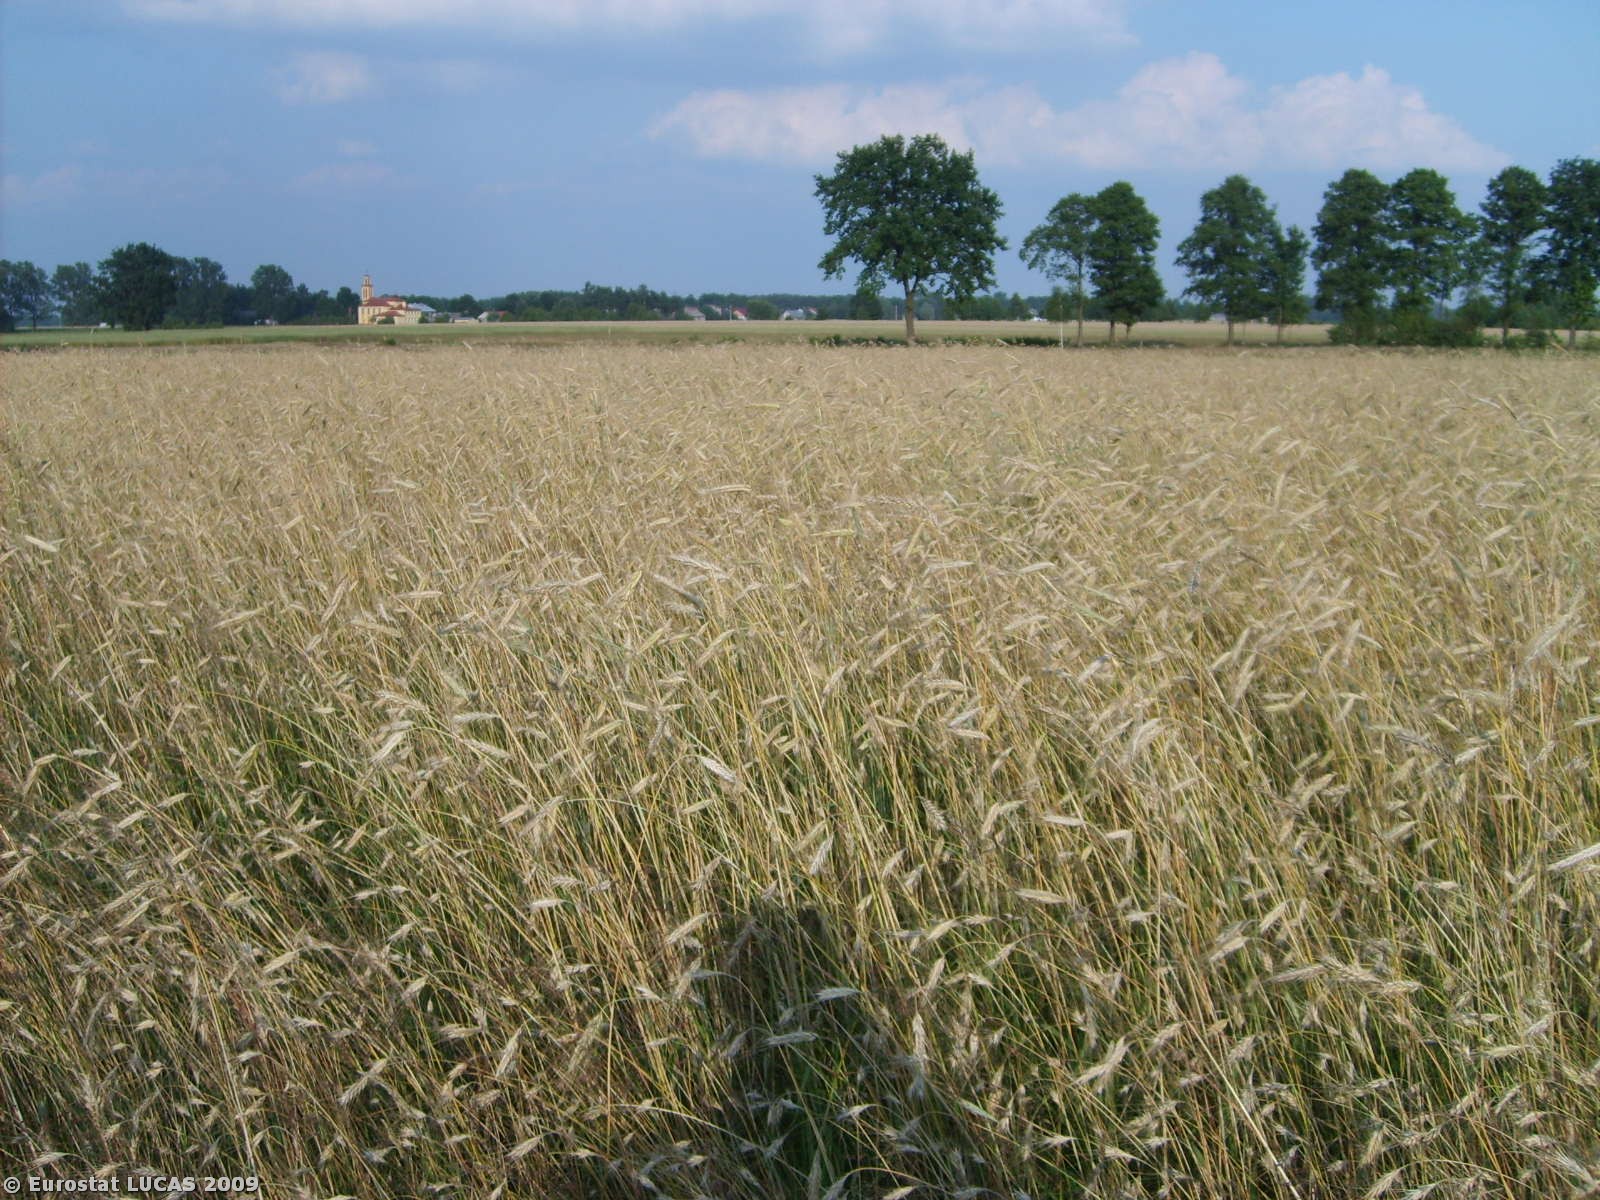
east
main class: Cropland
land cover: Rye
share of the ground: > 75 %
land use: Agriculture (excluding fallow land and kitchen gardens)
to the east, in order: Rye; Grass margins; Grassland without tree/shrub cover; Grass margins; Oats
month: July
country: PL
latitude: 52.4132
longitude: 21.7126
